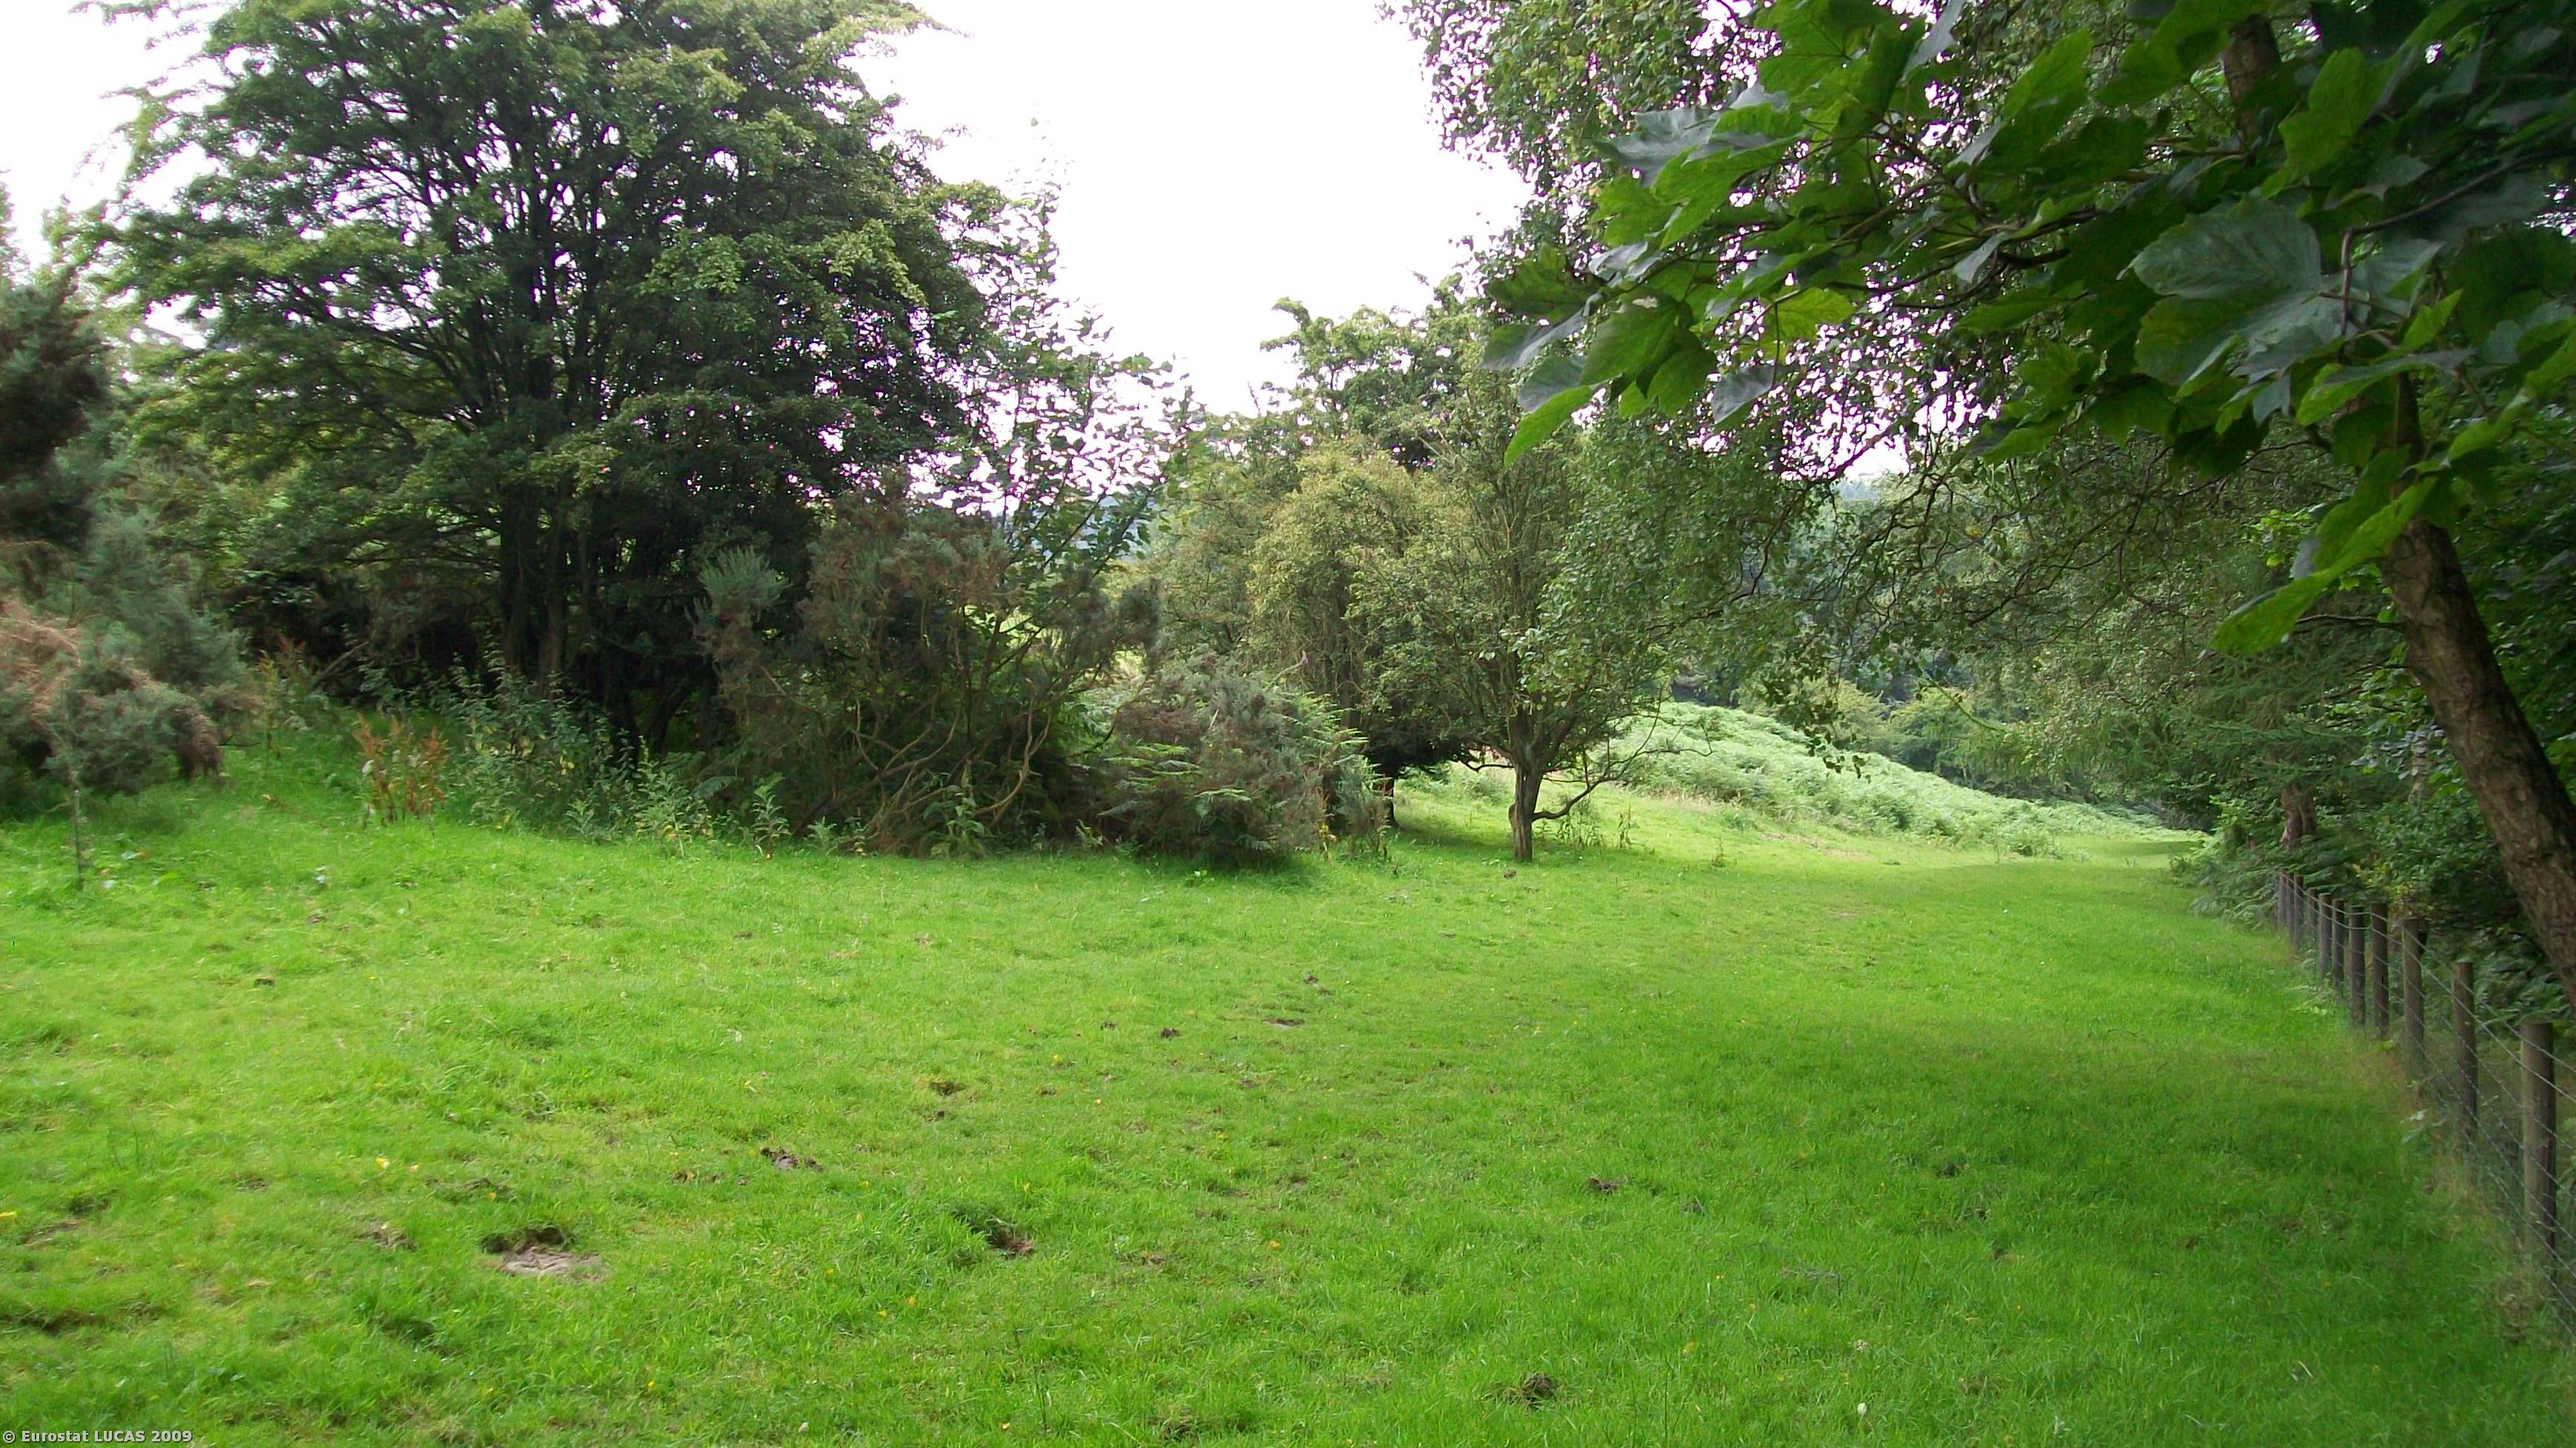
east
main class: Woodland
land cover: Mixed woodland
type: hemiboreal forest and nemoral coniferous forest and mixed broadleaved-coniferous forest
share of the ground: > 75 %
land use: Forestry
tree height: > 5 m
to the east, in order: Mixed woodland; Grassland with sparse tree/shrub cover; Grassland without tree/shrub cover; Broadleaved woodland
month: August
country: GB
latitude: 54.2098
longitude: -1.1607
